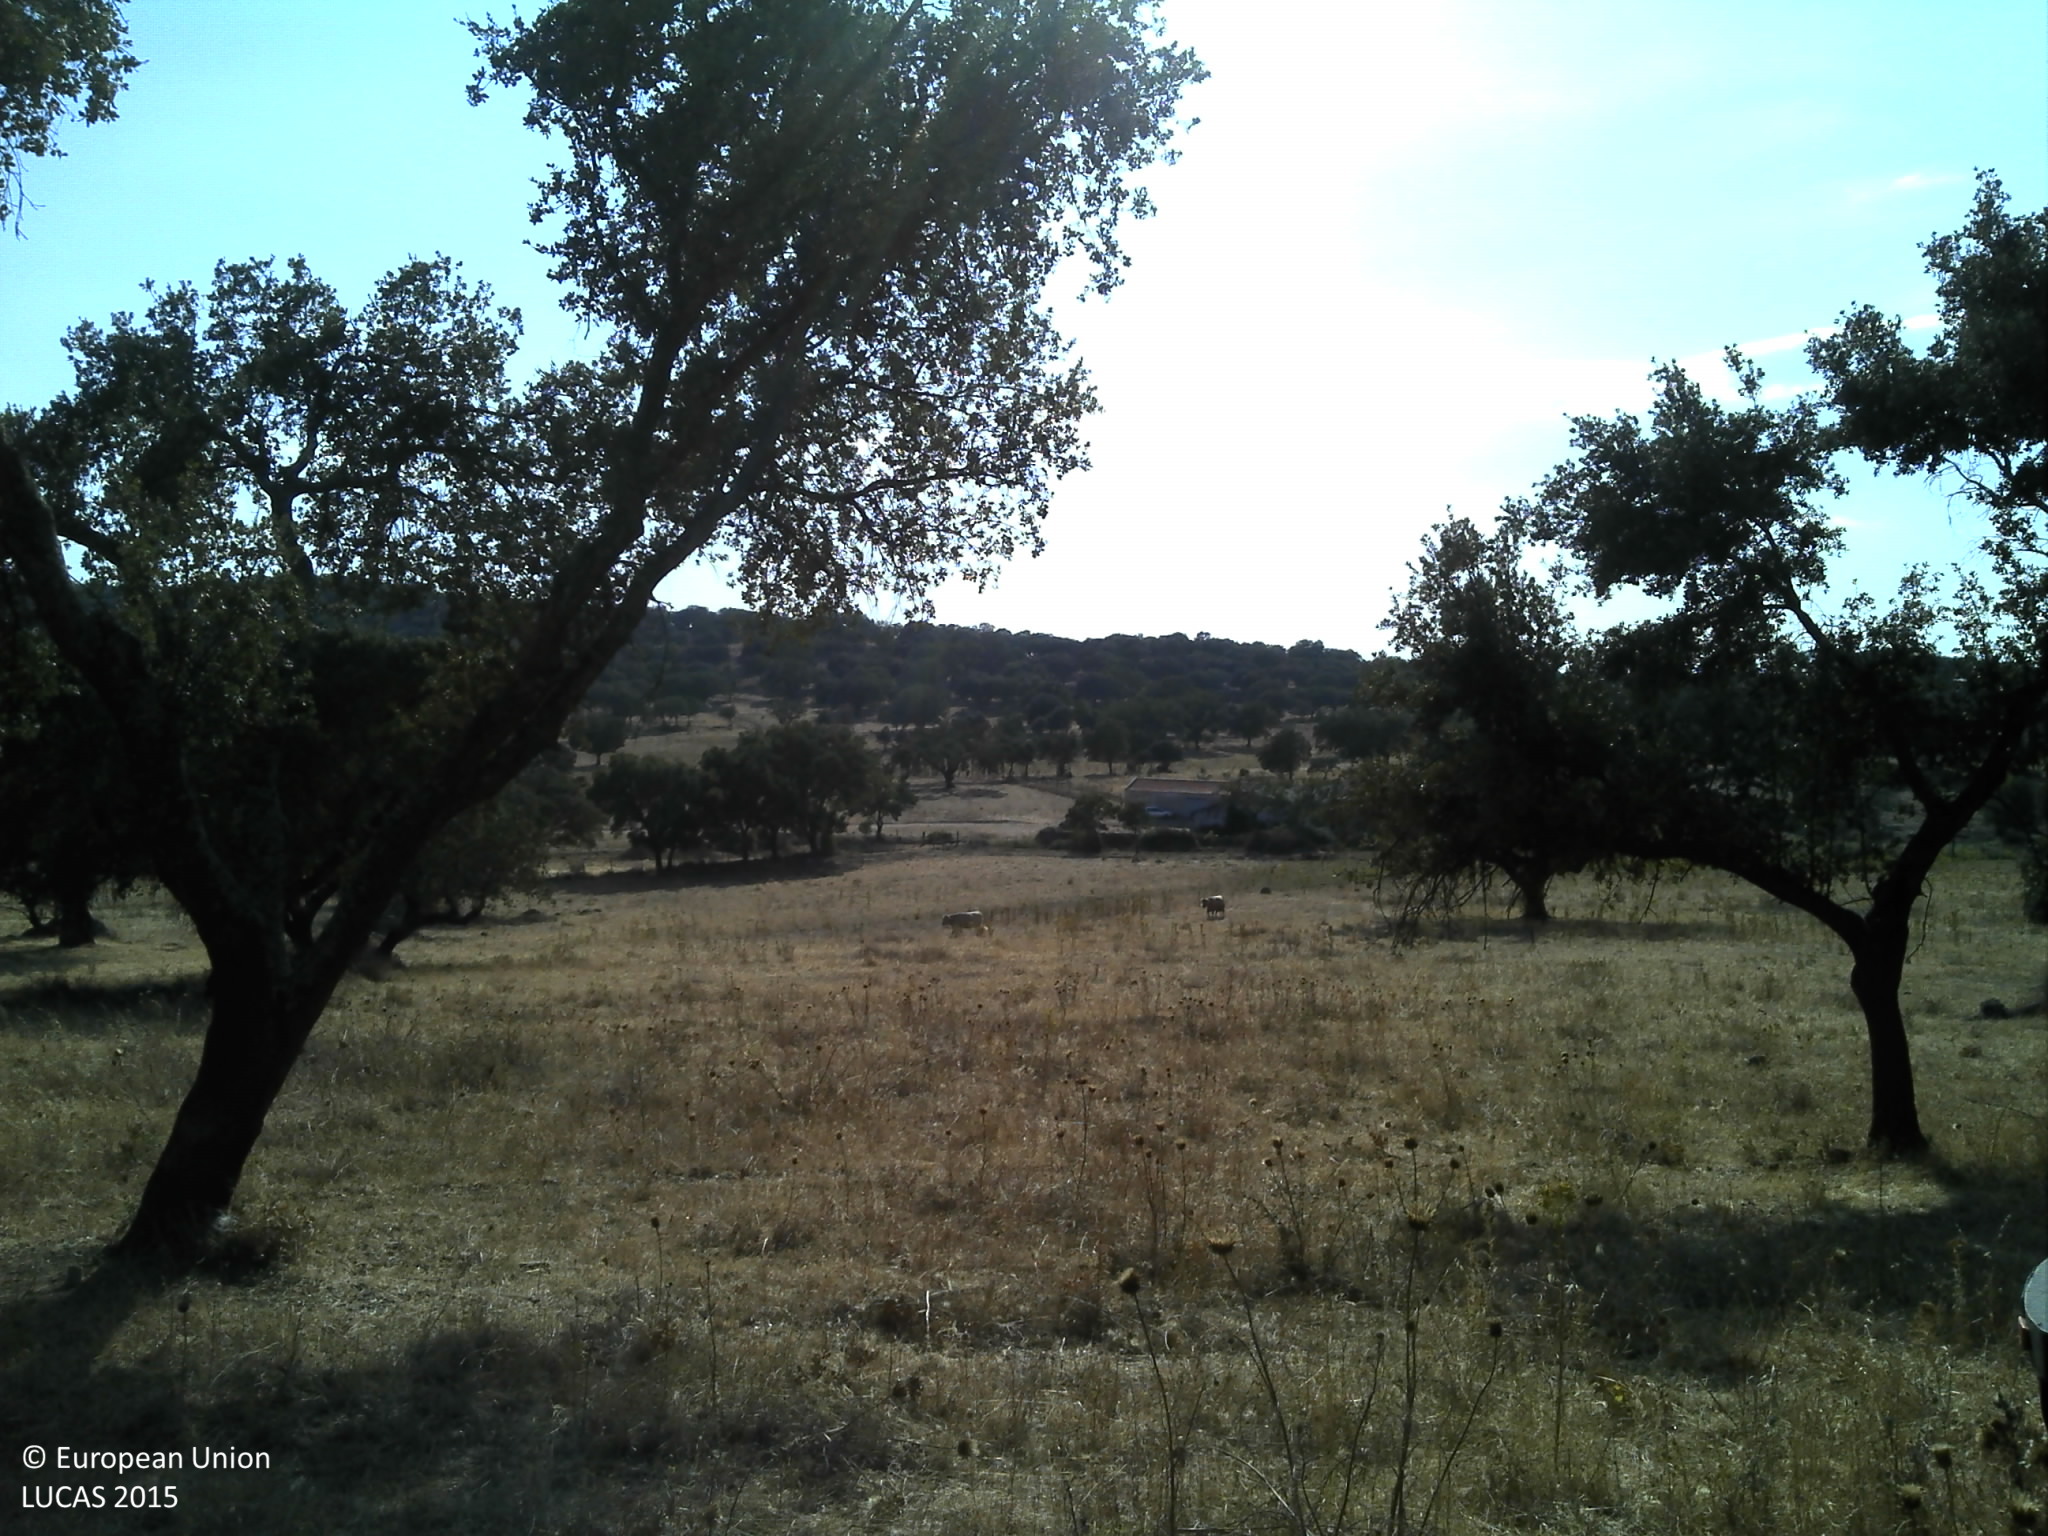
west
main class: Woodland
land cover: Broadleaved woodland
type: broadleaved evergreen forest
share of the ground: 10 - 25 %
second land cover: Grassland without tree/shrub cover
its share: 10 - 25 %
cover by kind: unconsolidated bare surface 70 %, broadleaved forest trees 15 %, herbaceous plants 15 %
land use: Forestry
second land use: Agriculture (excluding fallow land and kitchen gardens)
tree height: > 5 m
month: August
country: PT
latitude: 39.3088
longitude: -7.4972
